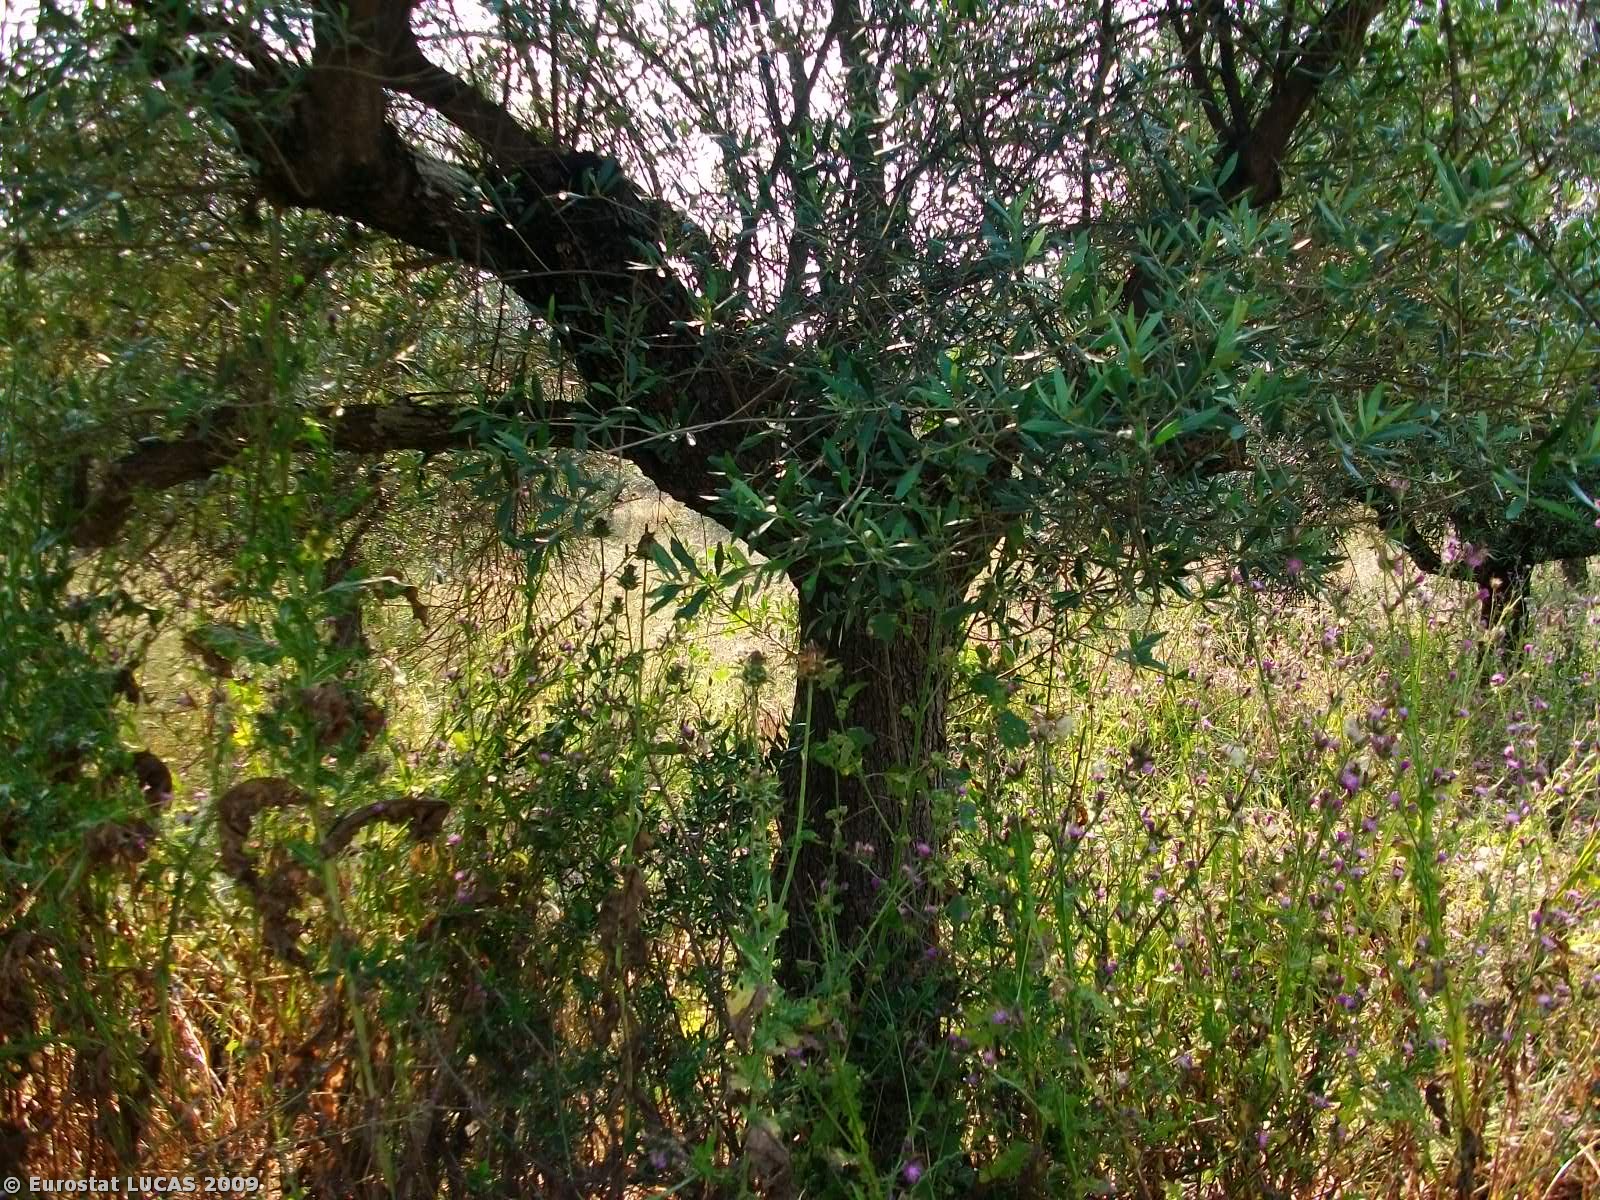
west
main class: Cropland
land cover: Olive groves
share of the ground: 25 - 50 %
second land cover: Grassland with sparse tree/shrub cover
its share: > 75 %
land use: Fallow land
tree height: < 5 m
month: May
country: GR
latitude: 37.1556
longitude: 22.3766
